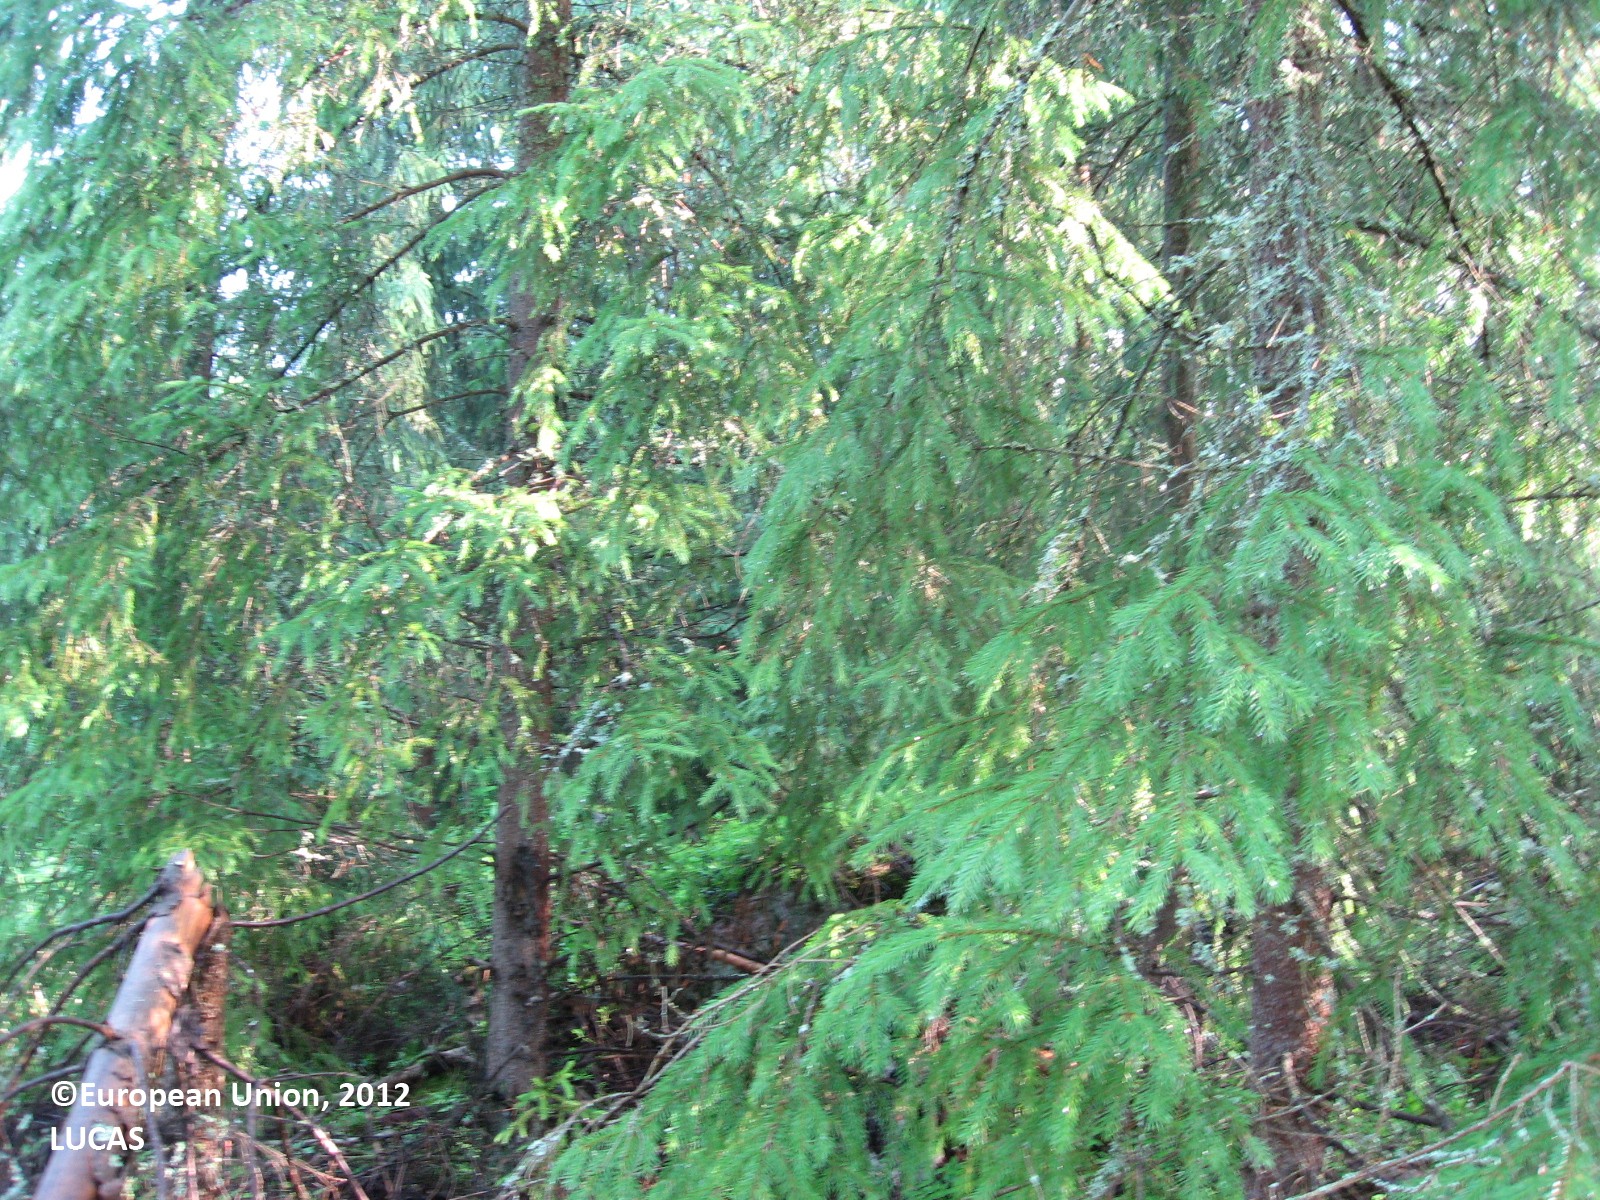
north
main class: Woodland
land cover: Other coniferous woodland
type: boreal forest
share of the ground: 25 - 50 %
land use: Forestry
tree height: > 5 m
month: June
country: FI
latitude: 60.6394
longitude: 26.3316
